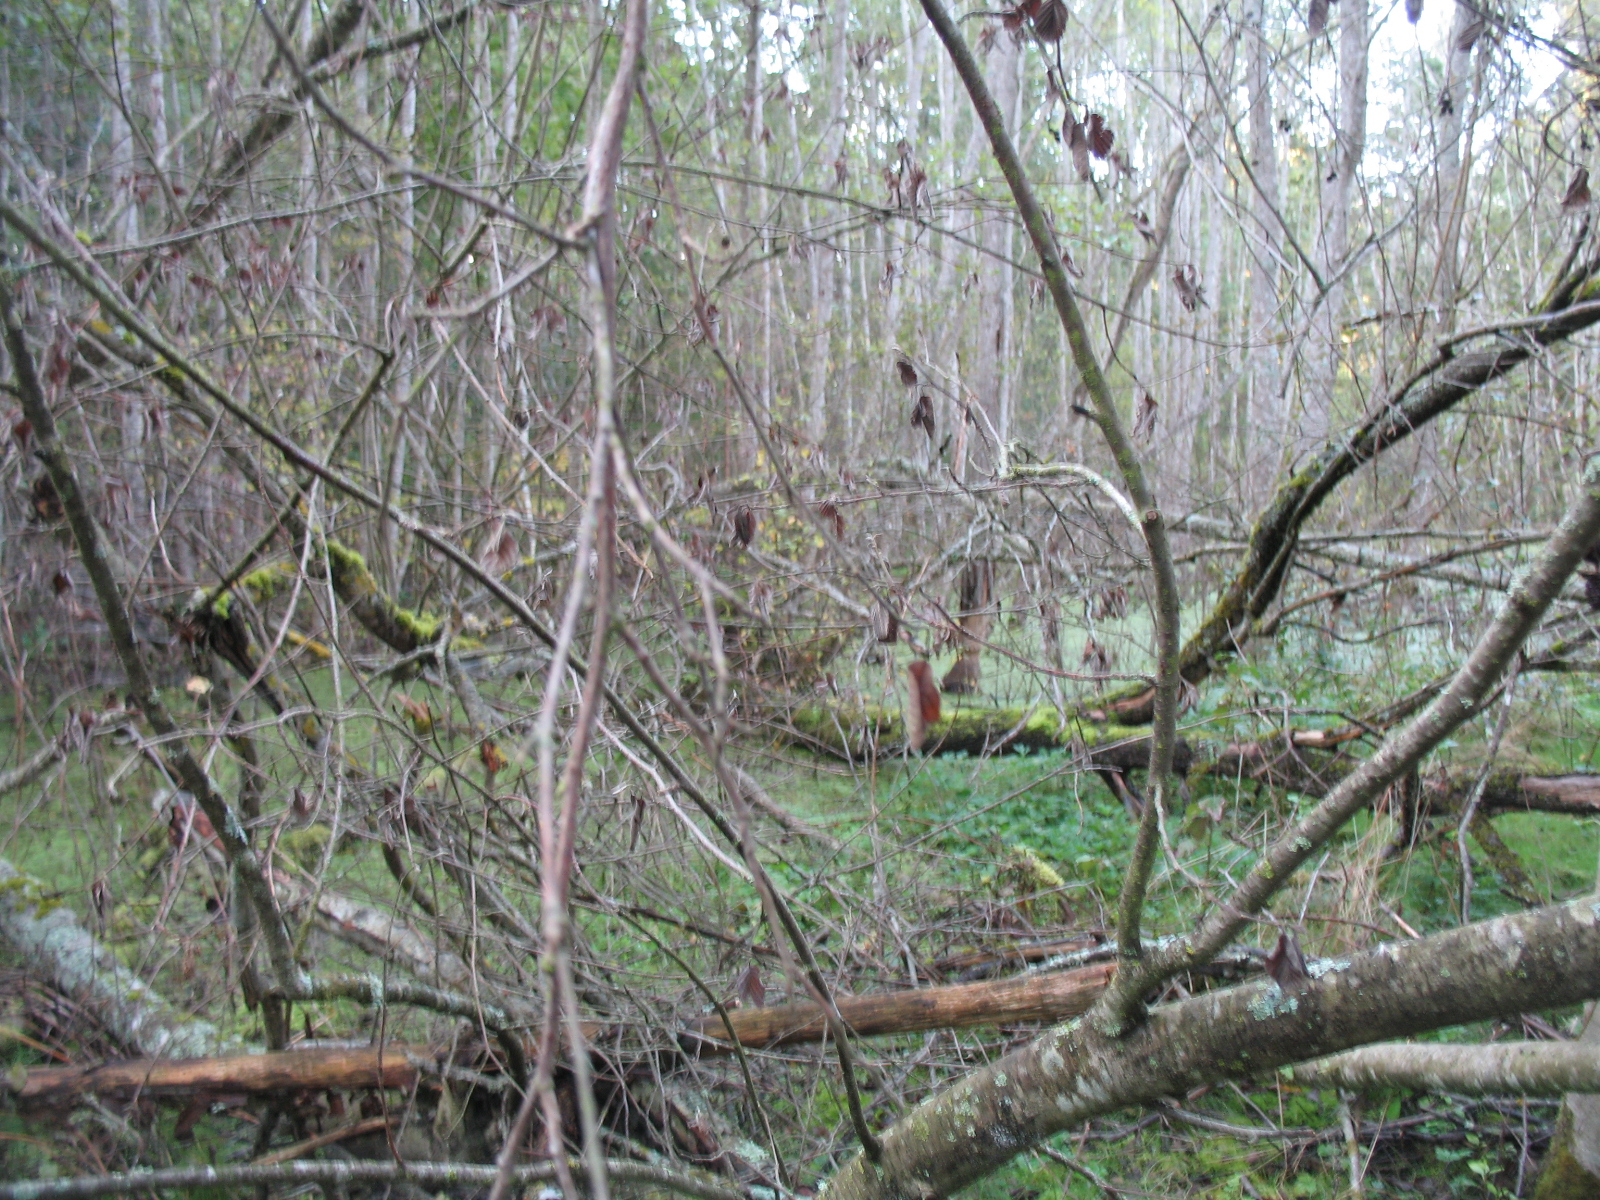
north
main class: Woodland
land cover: Broadleaved woodland
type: floodplain forest
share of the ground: > 75 %
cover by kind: broadleaved forest trees 80 %, herbaceous plants 10 %, lichens and mosses 5 %
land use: Forestry
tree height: > 5 m
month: September
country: LV
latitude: 56.1611
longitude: 25.8959
